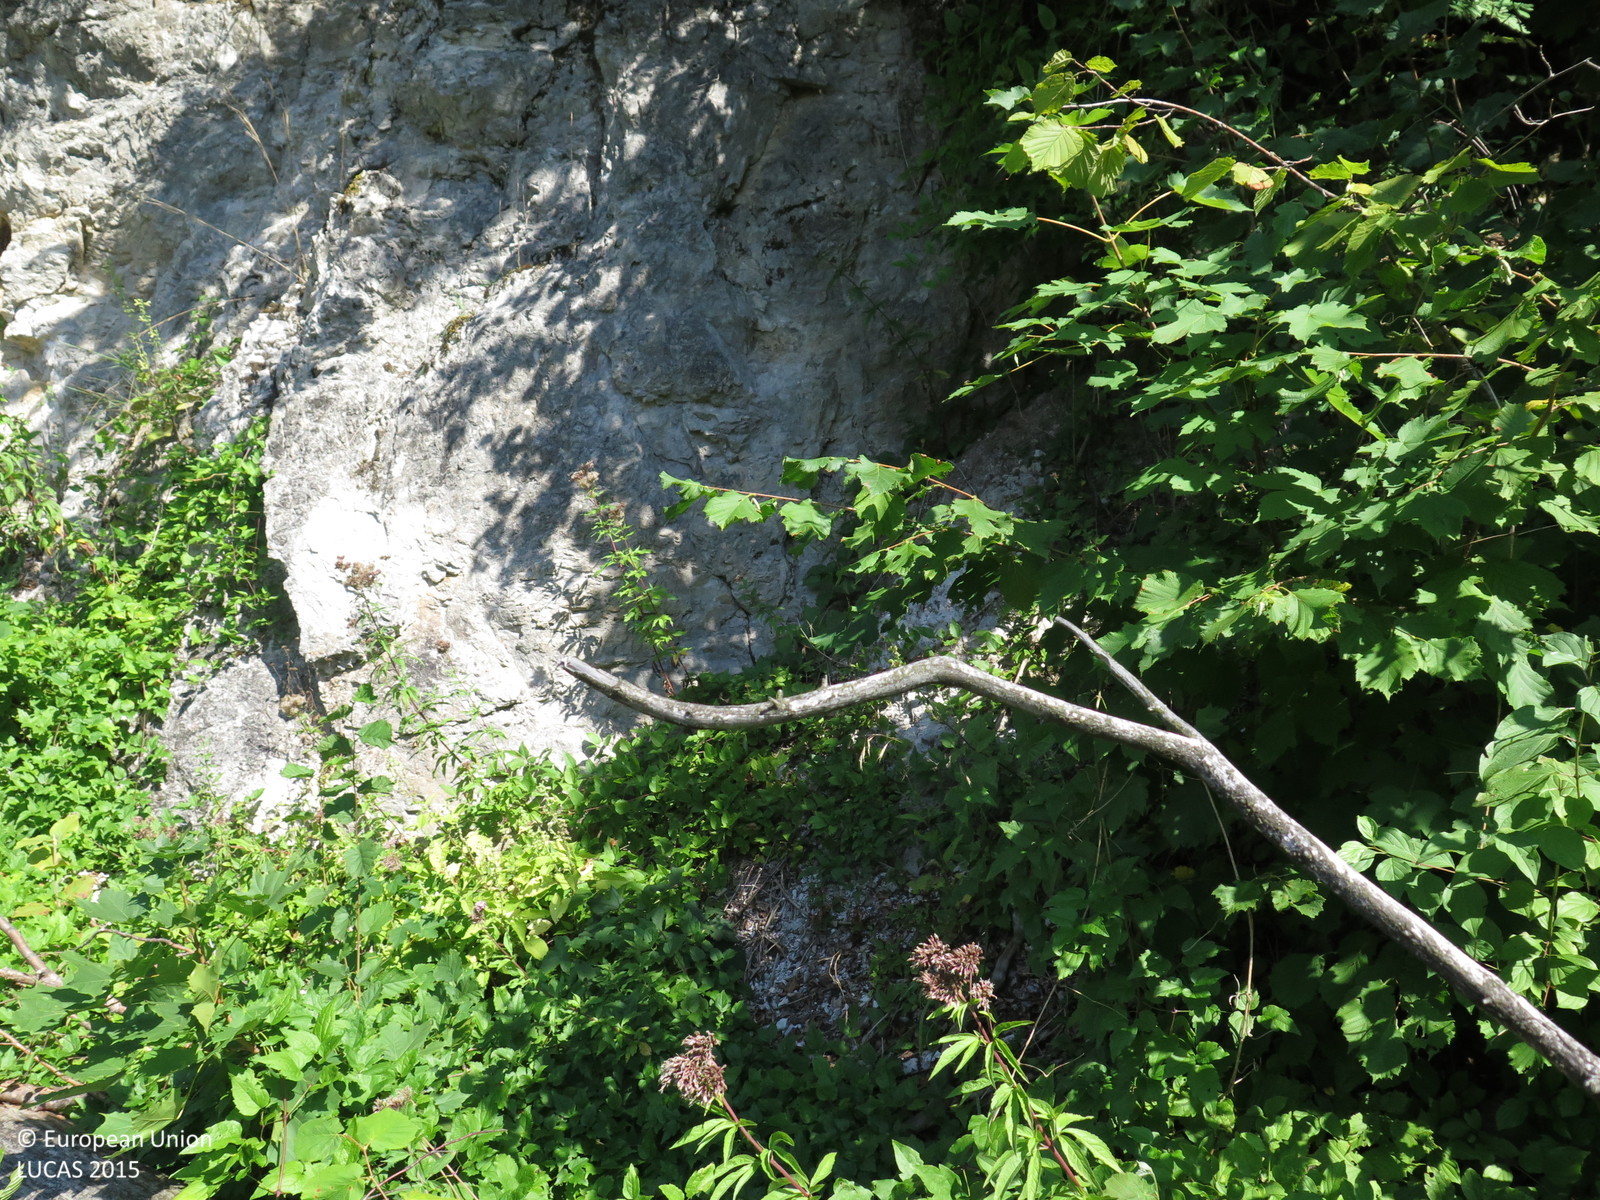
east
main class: Grassland
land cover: Grassland with sparse tree/shrub cover
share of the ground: > 75 %
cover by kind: herbaceous plants 90 %, broadleaved forest trees 5 %, shrubs 5 %
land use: Semi-natural and natural areas not in use
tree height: < 5 m
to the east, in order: Grassland with sparse tree/shrub cover; Rocks and stones; Other mixed woodland; Grass margins; Sand; Paved roads, cycling and walking lanes; Grass margins; Ditches and canals; Grassland without tree/shrub cover; Sand
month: August
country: HR
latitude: 45.3948
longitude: 14.8110
